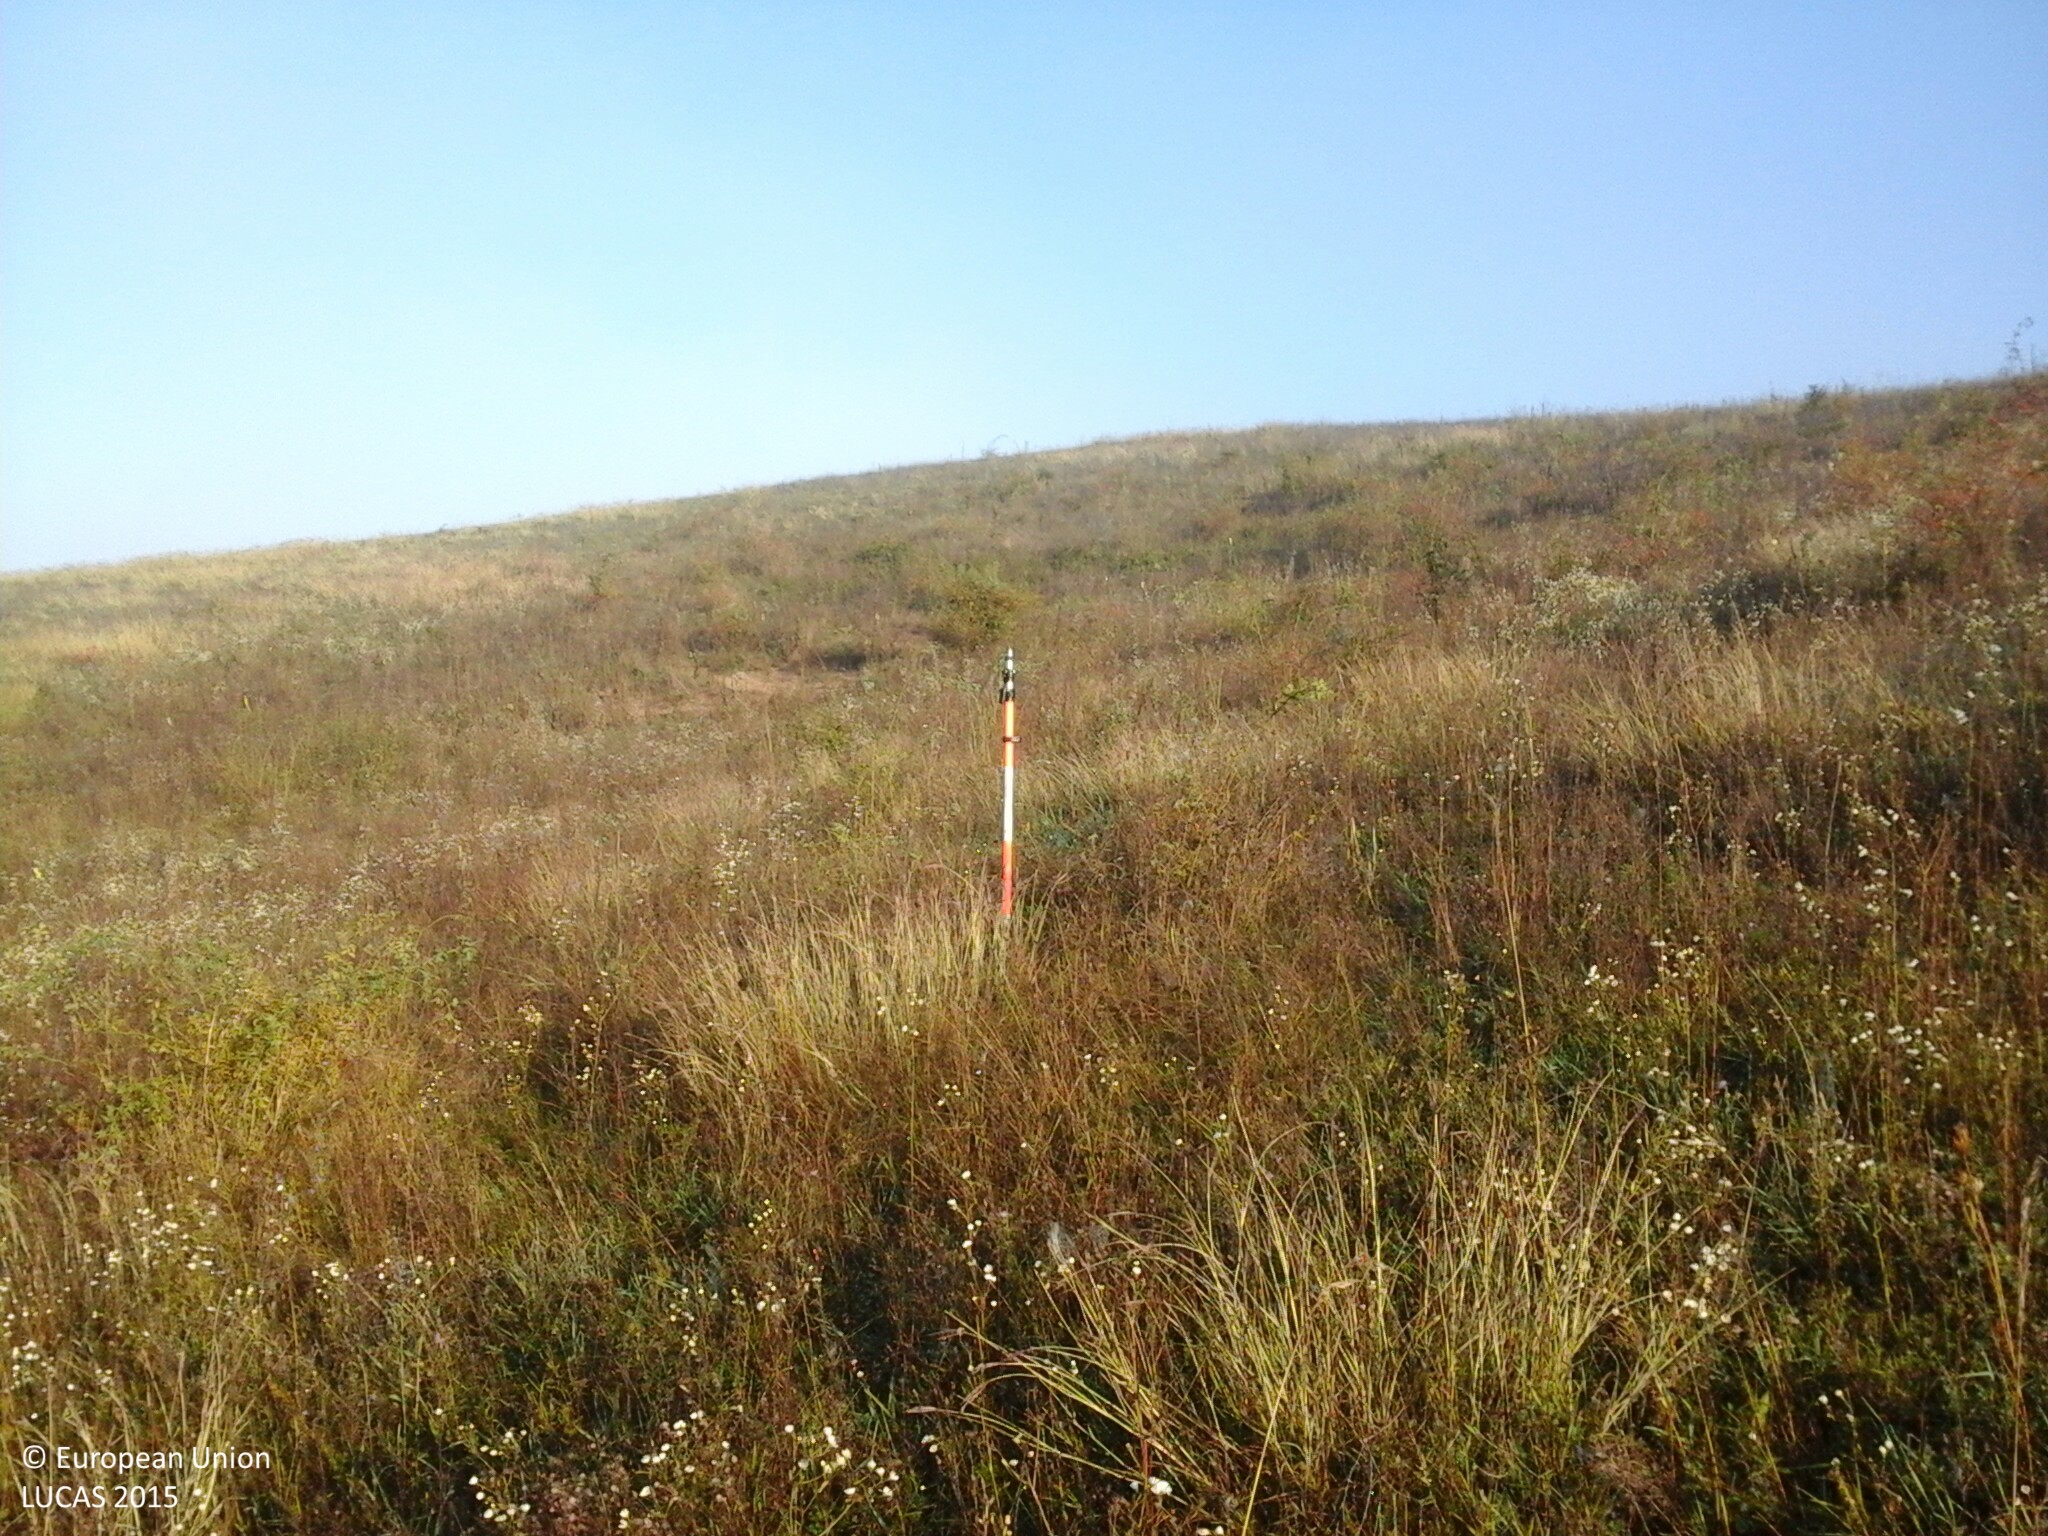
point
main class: Grassland
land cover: Spontaneously vegetated surfaces
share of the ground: > 75 %
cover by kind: herbaceous plants 100 %
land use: Semi-natural and natural areas not in use
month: September
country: HU
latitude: 48.1649
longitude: 20.0186
